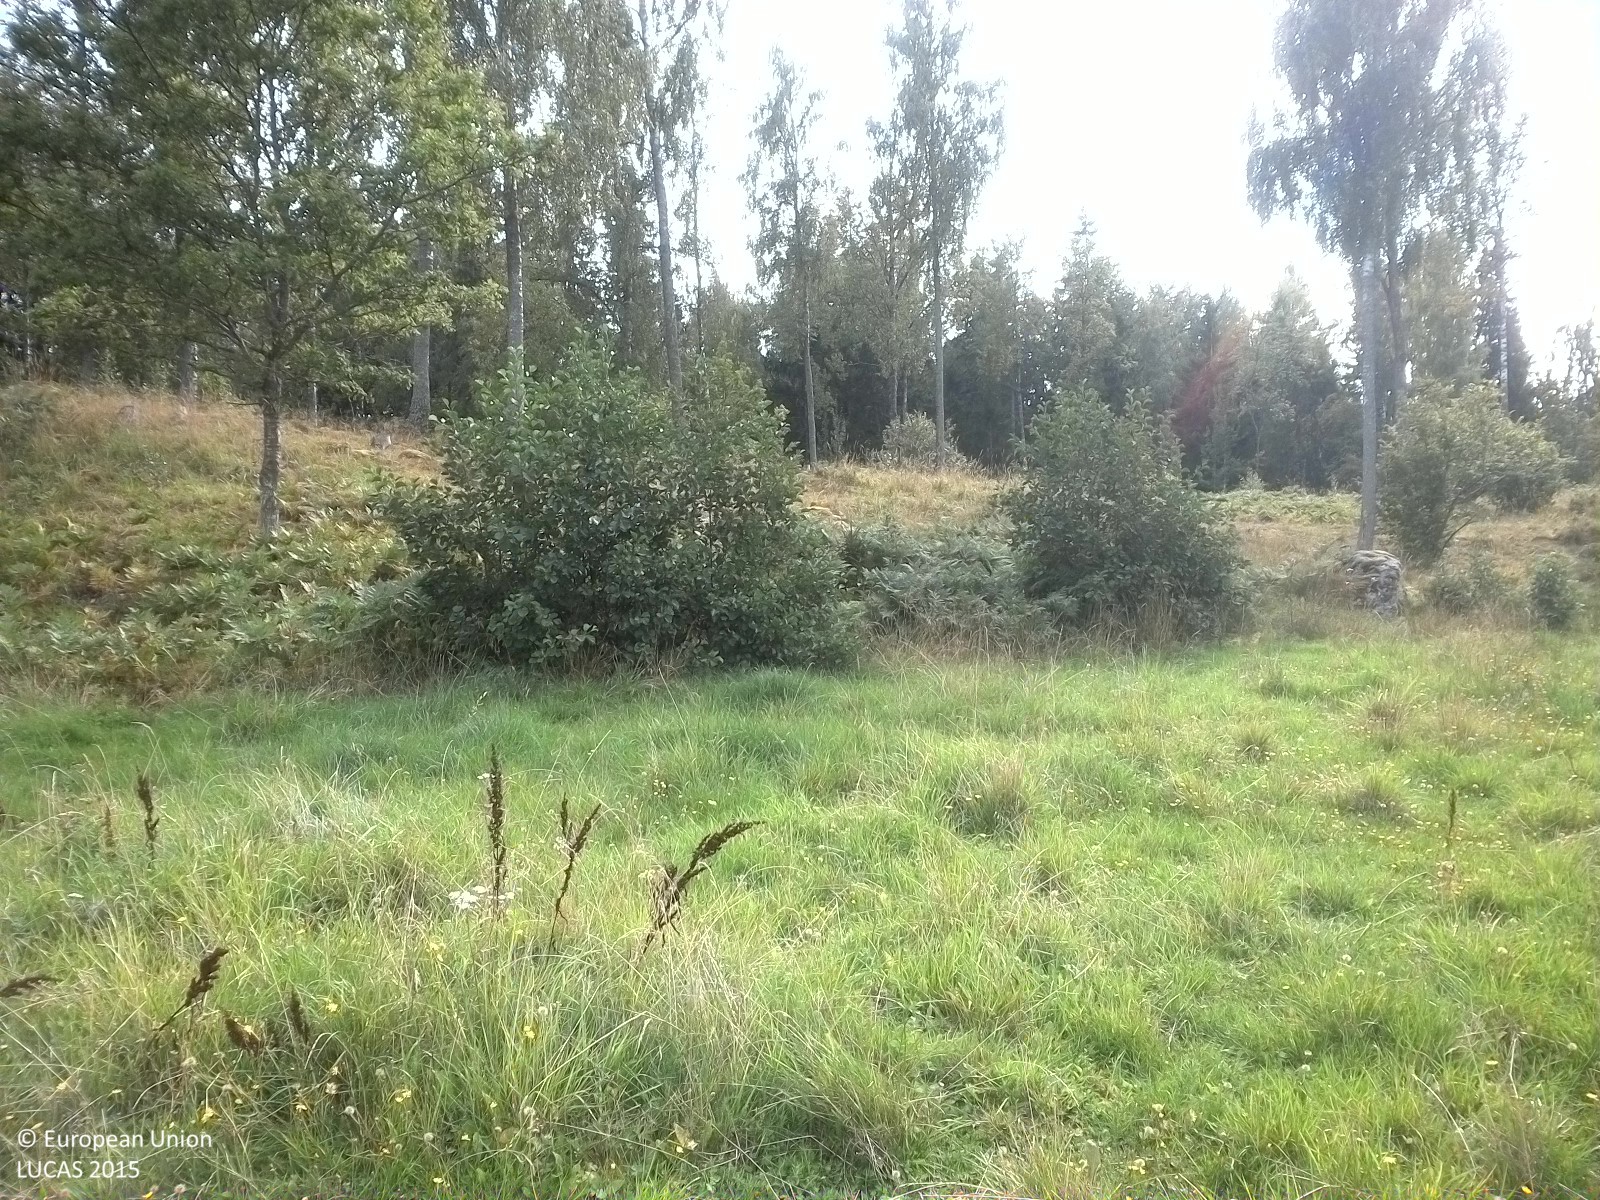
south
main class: Grassland
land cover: Grassland without tree/shrub cover
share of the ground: > 75 %
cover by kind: herbaceous plants 100 %
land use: Agriculture (excluding fallow land and kitchen gardens)
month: August
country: SE
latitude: 59.3165
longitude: 15.9129
